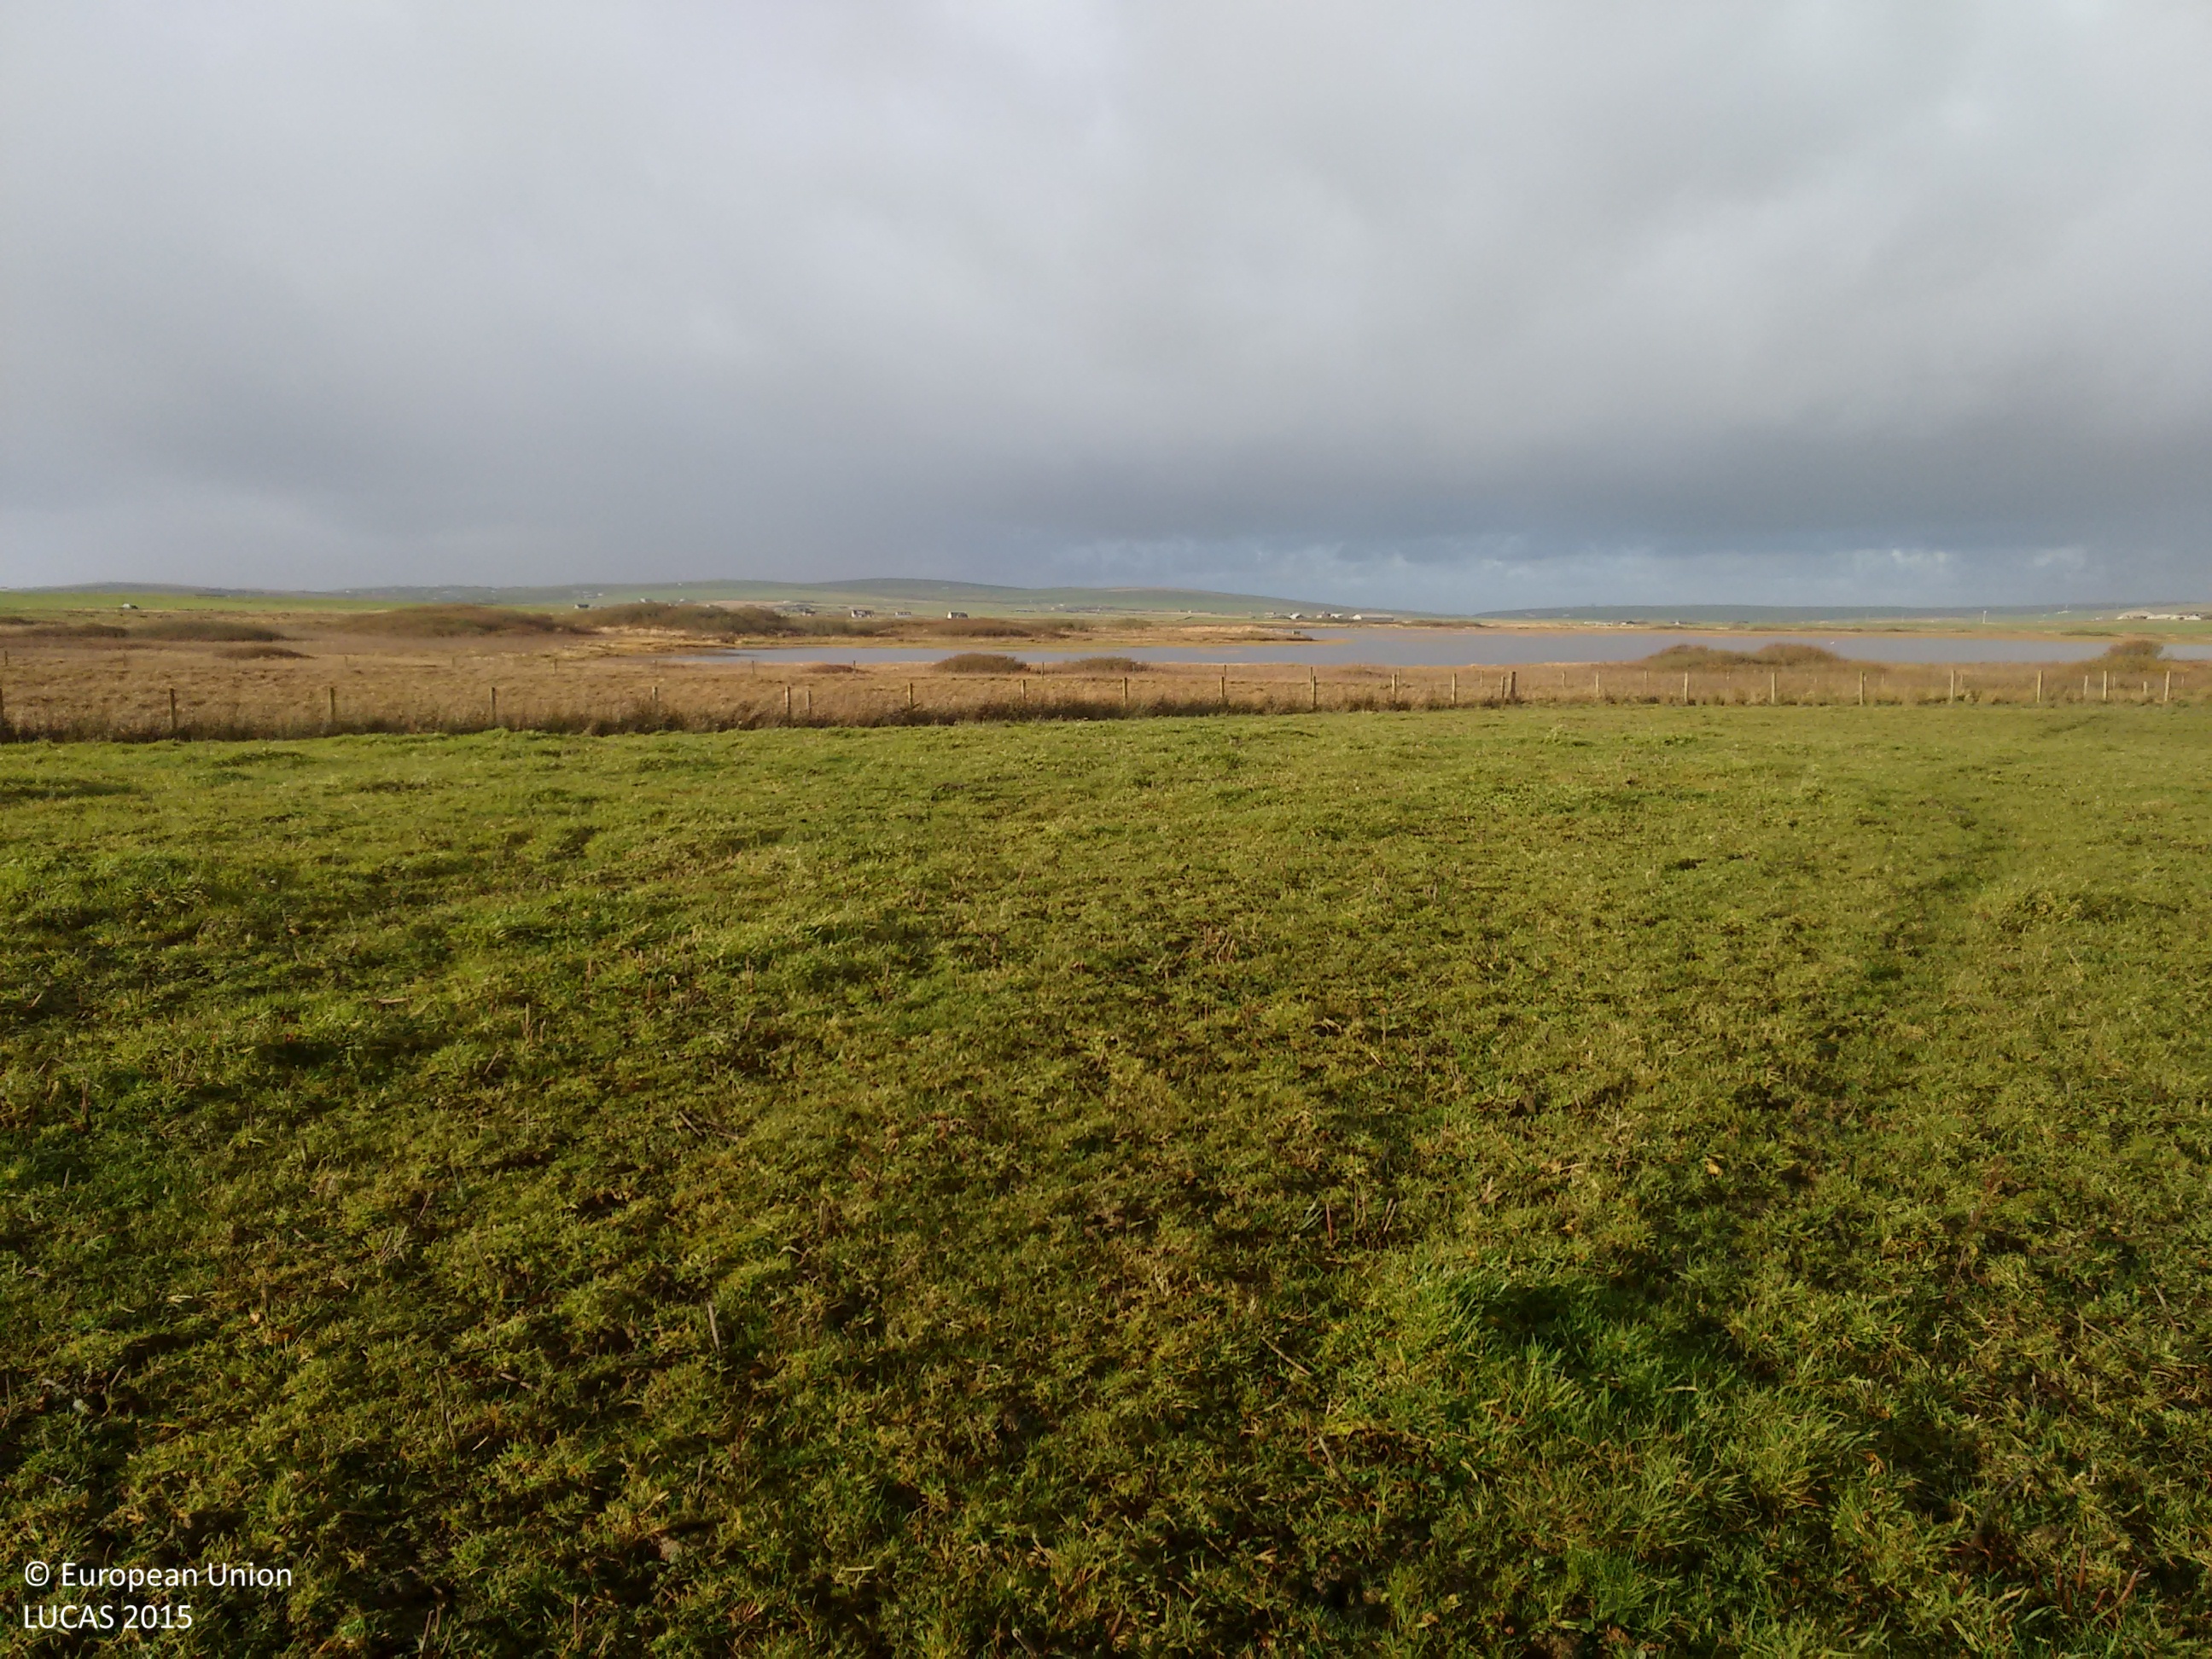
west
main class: Grassland
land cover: Grassland without tree/shrub cover
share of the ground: > 75 %
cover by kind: herbaceous plants 100 %
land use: Agriculture (excluding fallow land and kitchen gardens)
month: November
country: GB
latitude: 59.0785
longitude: -3.2285
